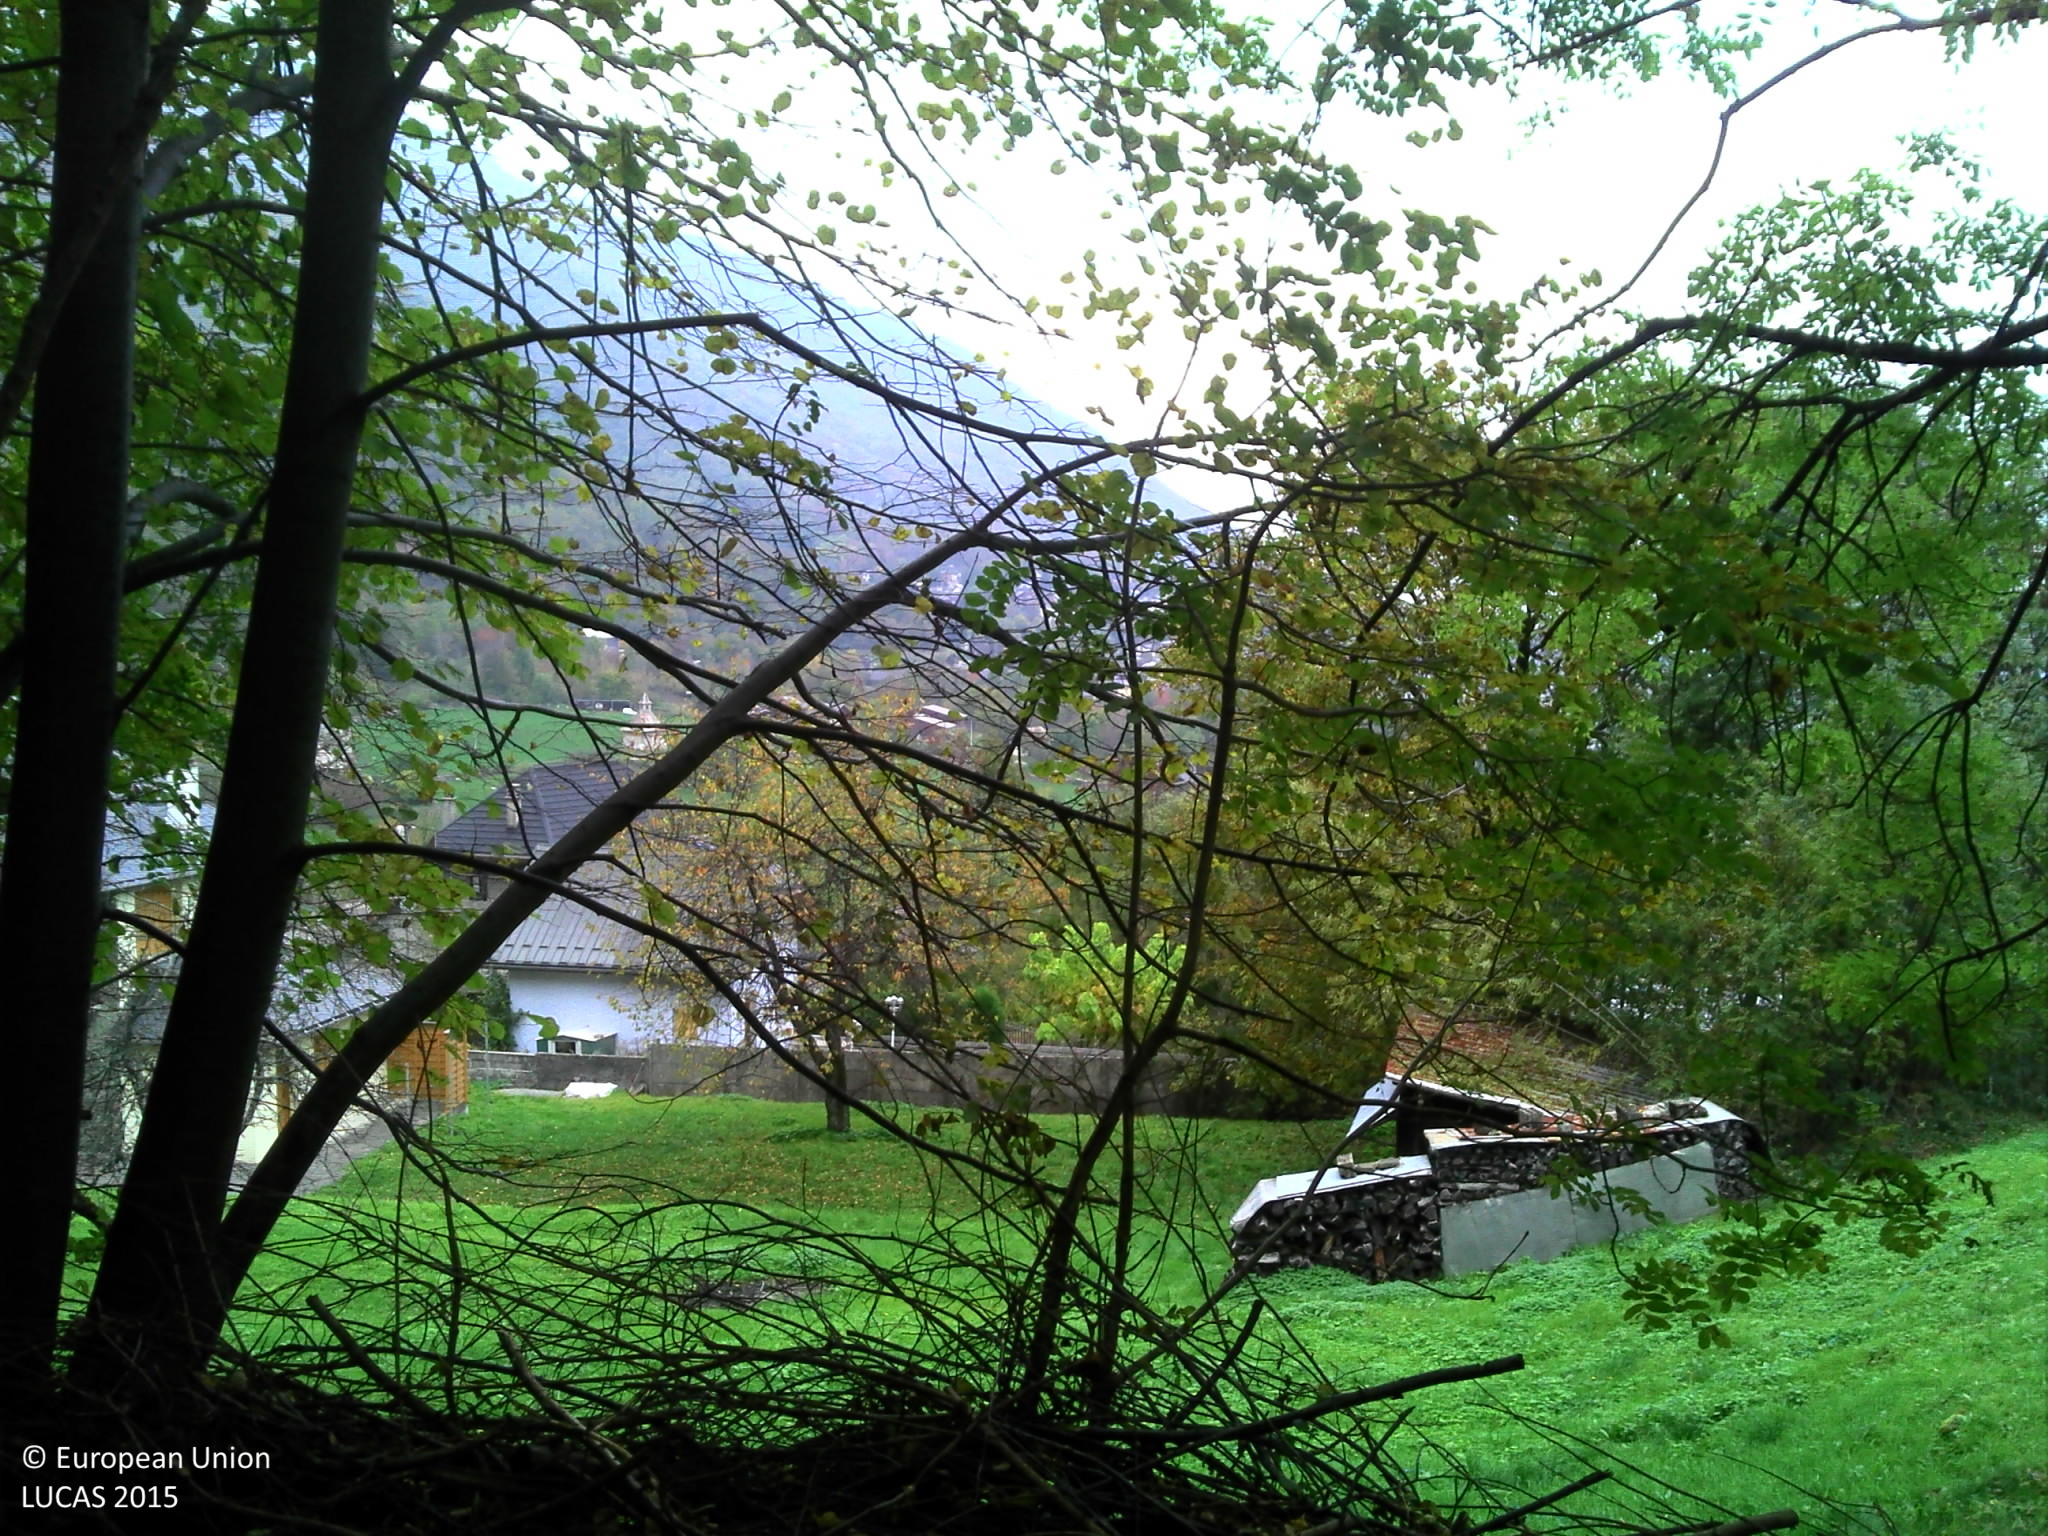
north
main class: Woodland
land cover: Broadleaved woodland
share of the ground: > 75 %
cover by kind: broadleaved forest trees 90 %, unconsolidated bare surface 10 %
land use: Residential
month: October
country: FR
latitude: 45.3842
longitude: 6.2628
